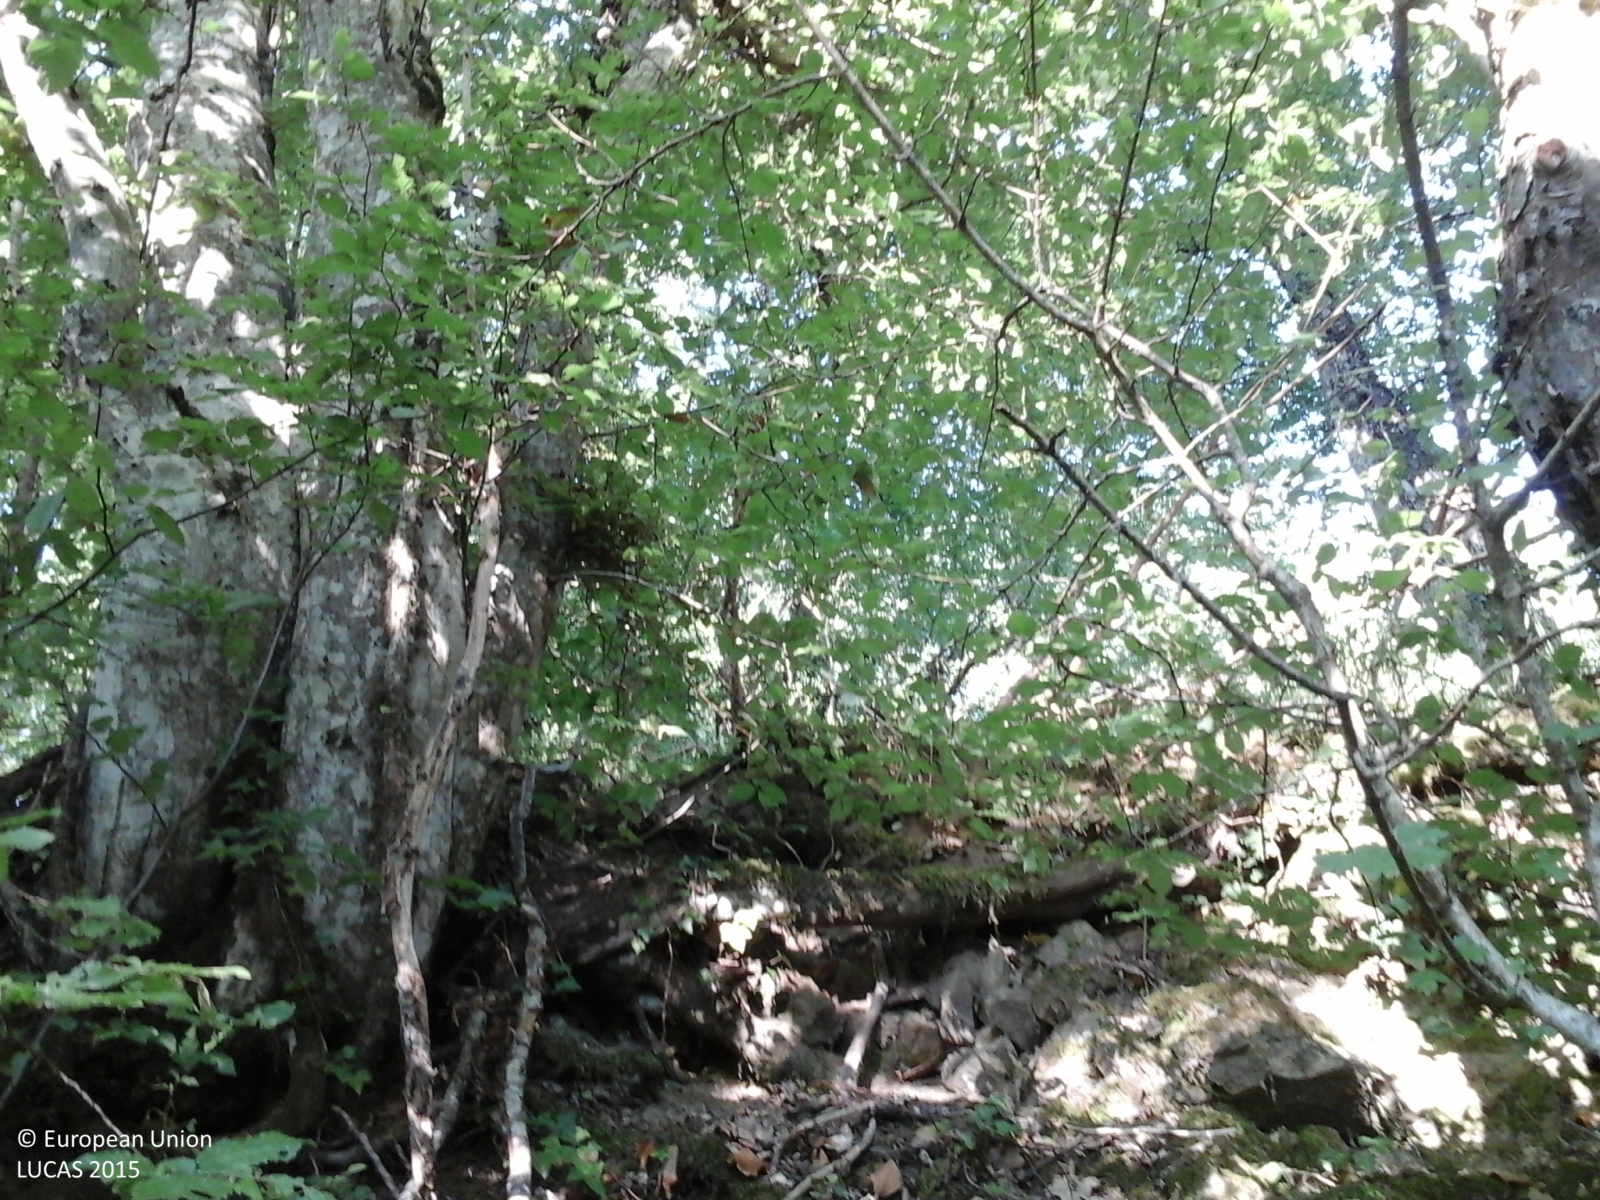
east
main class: Woodland
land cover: Broadleaved woodland
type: thermophilous deciduous forest
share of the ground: > 75 %
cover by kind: broadleaved forest trees 100 %
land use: Forestry
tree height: > 5 m
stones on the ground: 10 - 25 %
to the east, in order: Broadleaved woodland; Tracks; Broadleaved woodland; Tracks; Broadleaved woodland
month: June
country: IT
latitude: 43.8897
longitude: 11.4279
